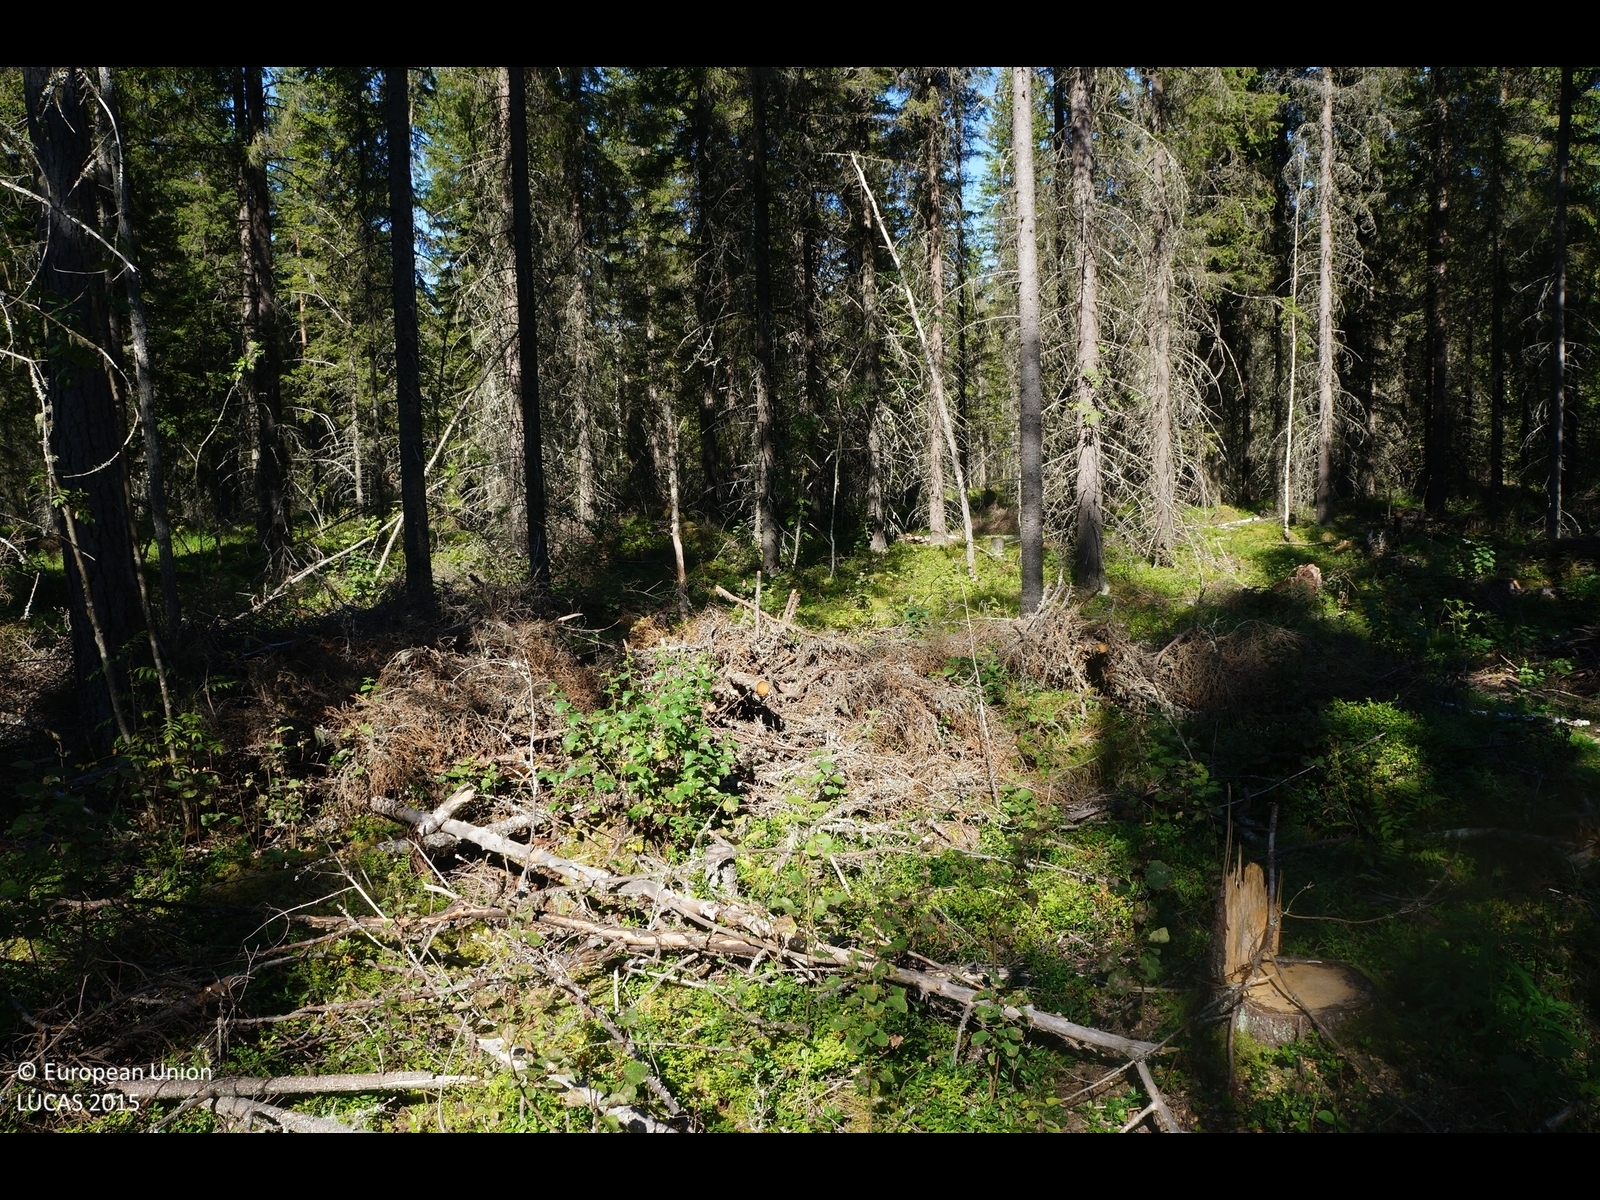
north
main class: Woodland
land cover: Spruce dominated coniferous woodland
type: boreal forest
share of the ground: 50 - 75 %
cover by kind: coniferous forest trees 50 %, shrubs 35 %, lichens and mosses 10 %, herbaceous plants 5 %
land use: Forestry
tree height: > 5 m
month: August
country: FI
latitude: 64.0141
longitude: 25.1643
